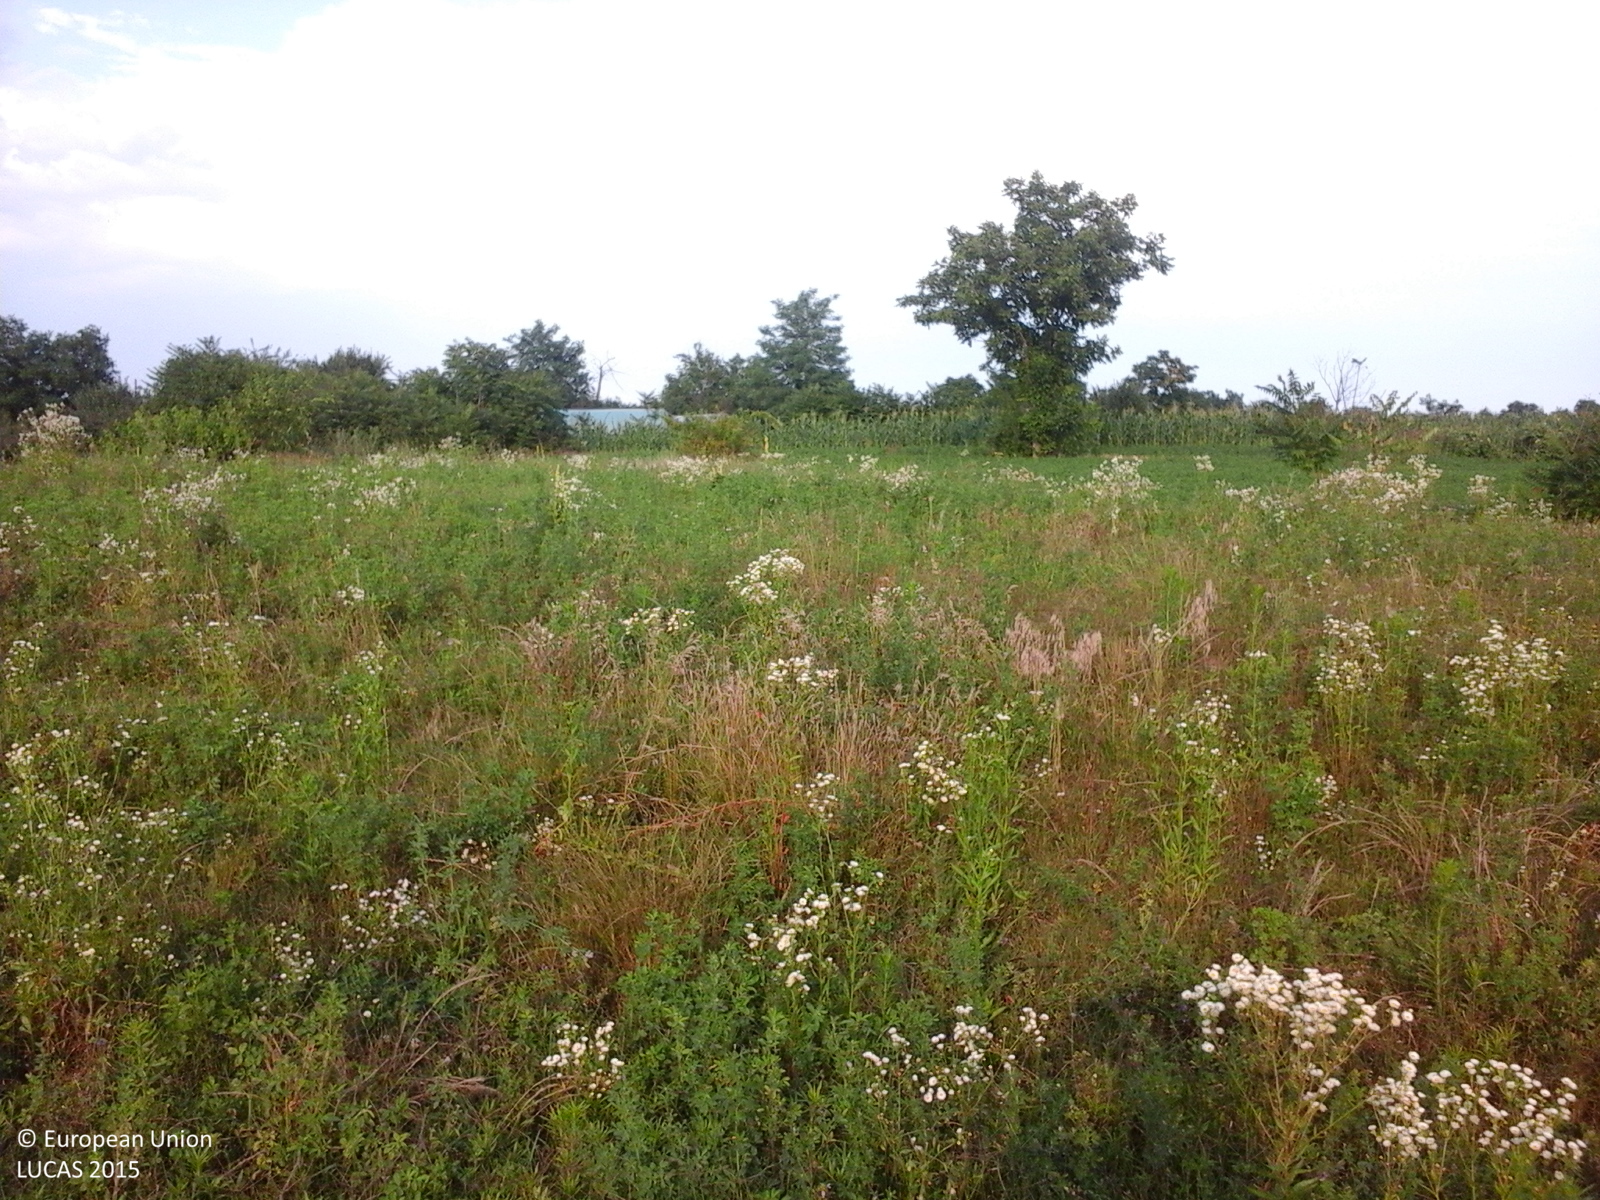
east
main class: Grassland
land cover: Spontaneously vegetated surfaces
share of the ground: > 75 %
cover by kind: herbaceous plants 100 %
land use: Agriculture (excluding fallow land and kitchen gardens)
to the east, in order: Spontaneously vegetated surfaces; Maize; Vineyards; Fences; Maize; Fences; Lucerne; Fences; Maize; Fences; Maize; Artificial constructions in urban areas
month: July
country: RO
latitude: 44.1621
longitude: 24.4095
